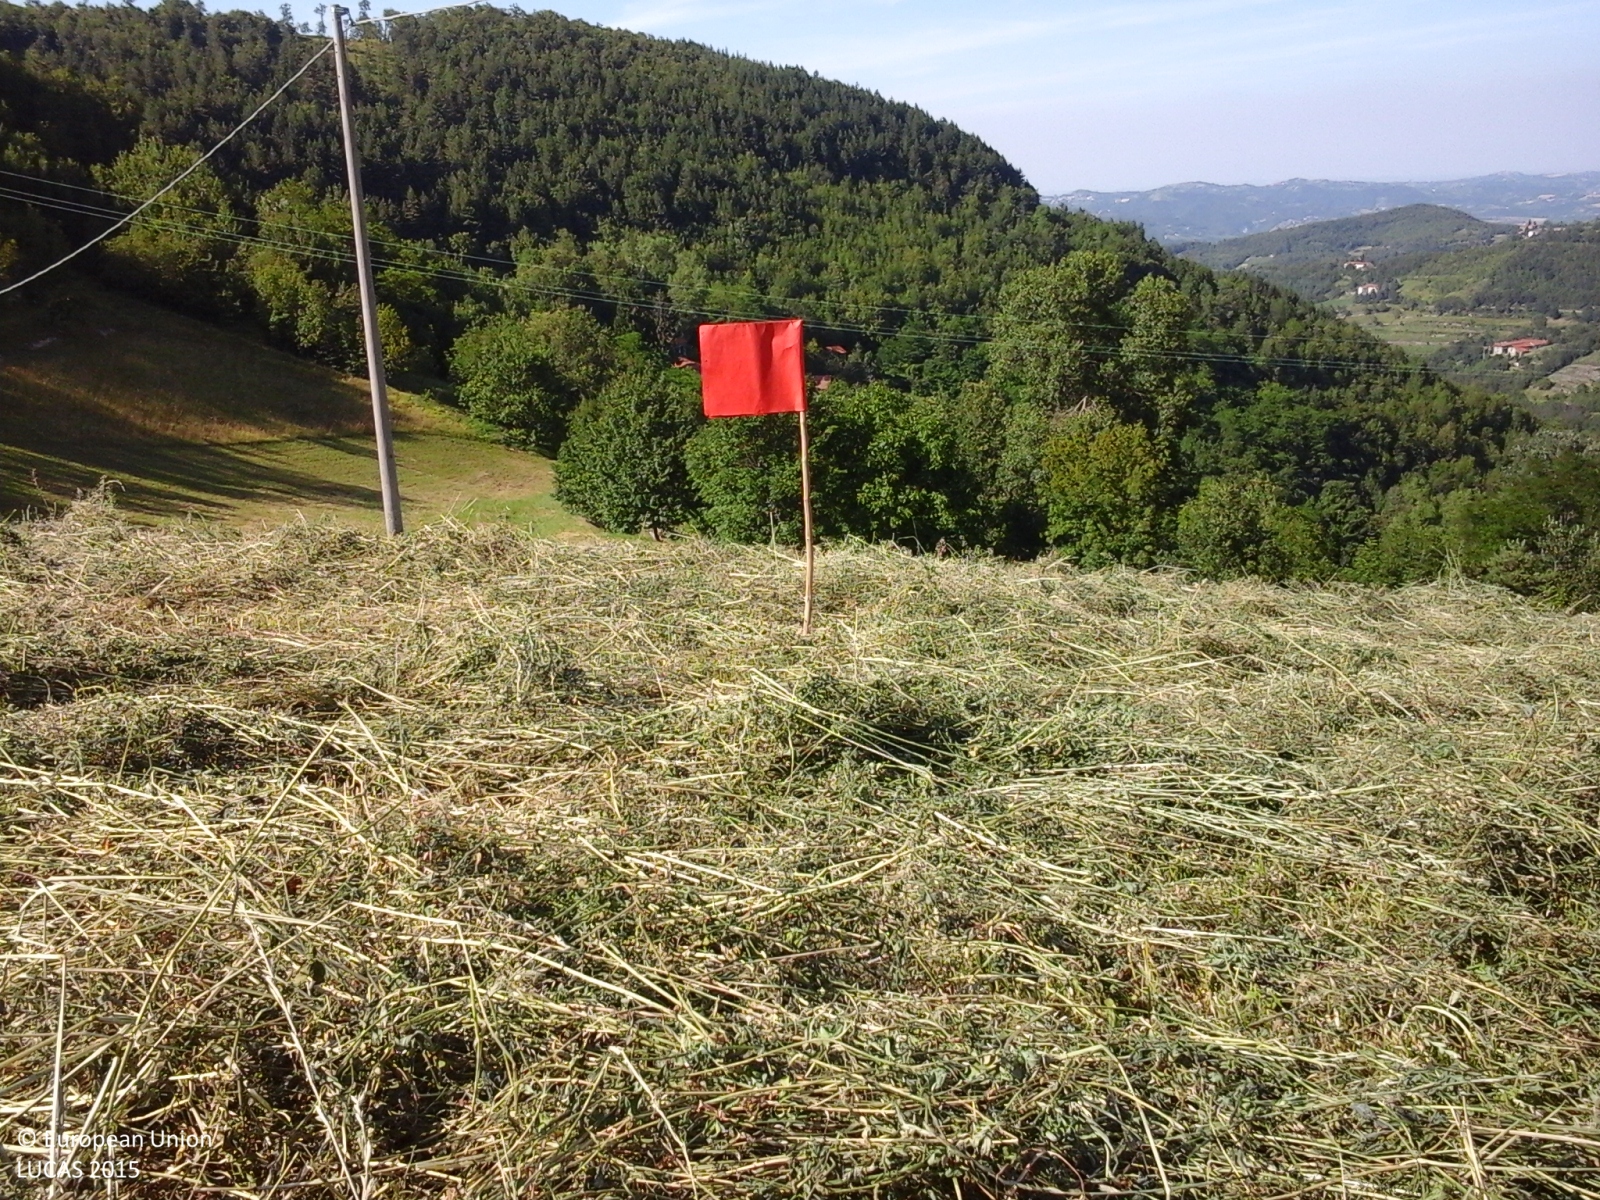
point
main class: Cropland
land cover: Lucerne
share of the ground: > 75 %
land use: Agriculture (excluding fallow land and kitchen gardens)
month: June
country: IT
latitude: 44.6073
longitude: 8.3025
